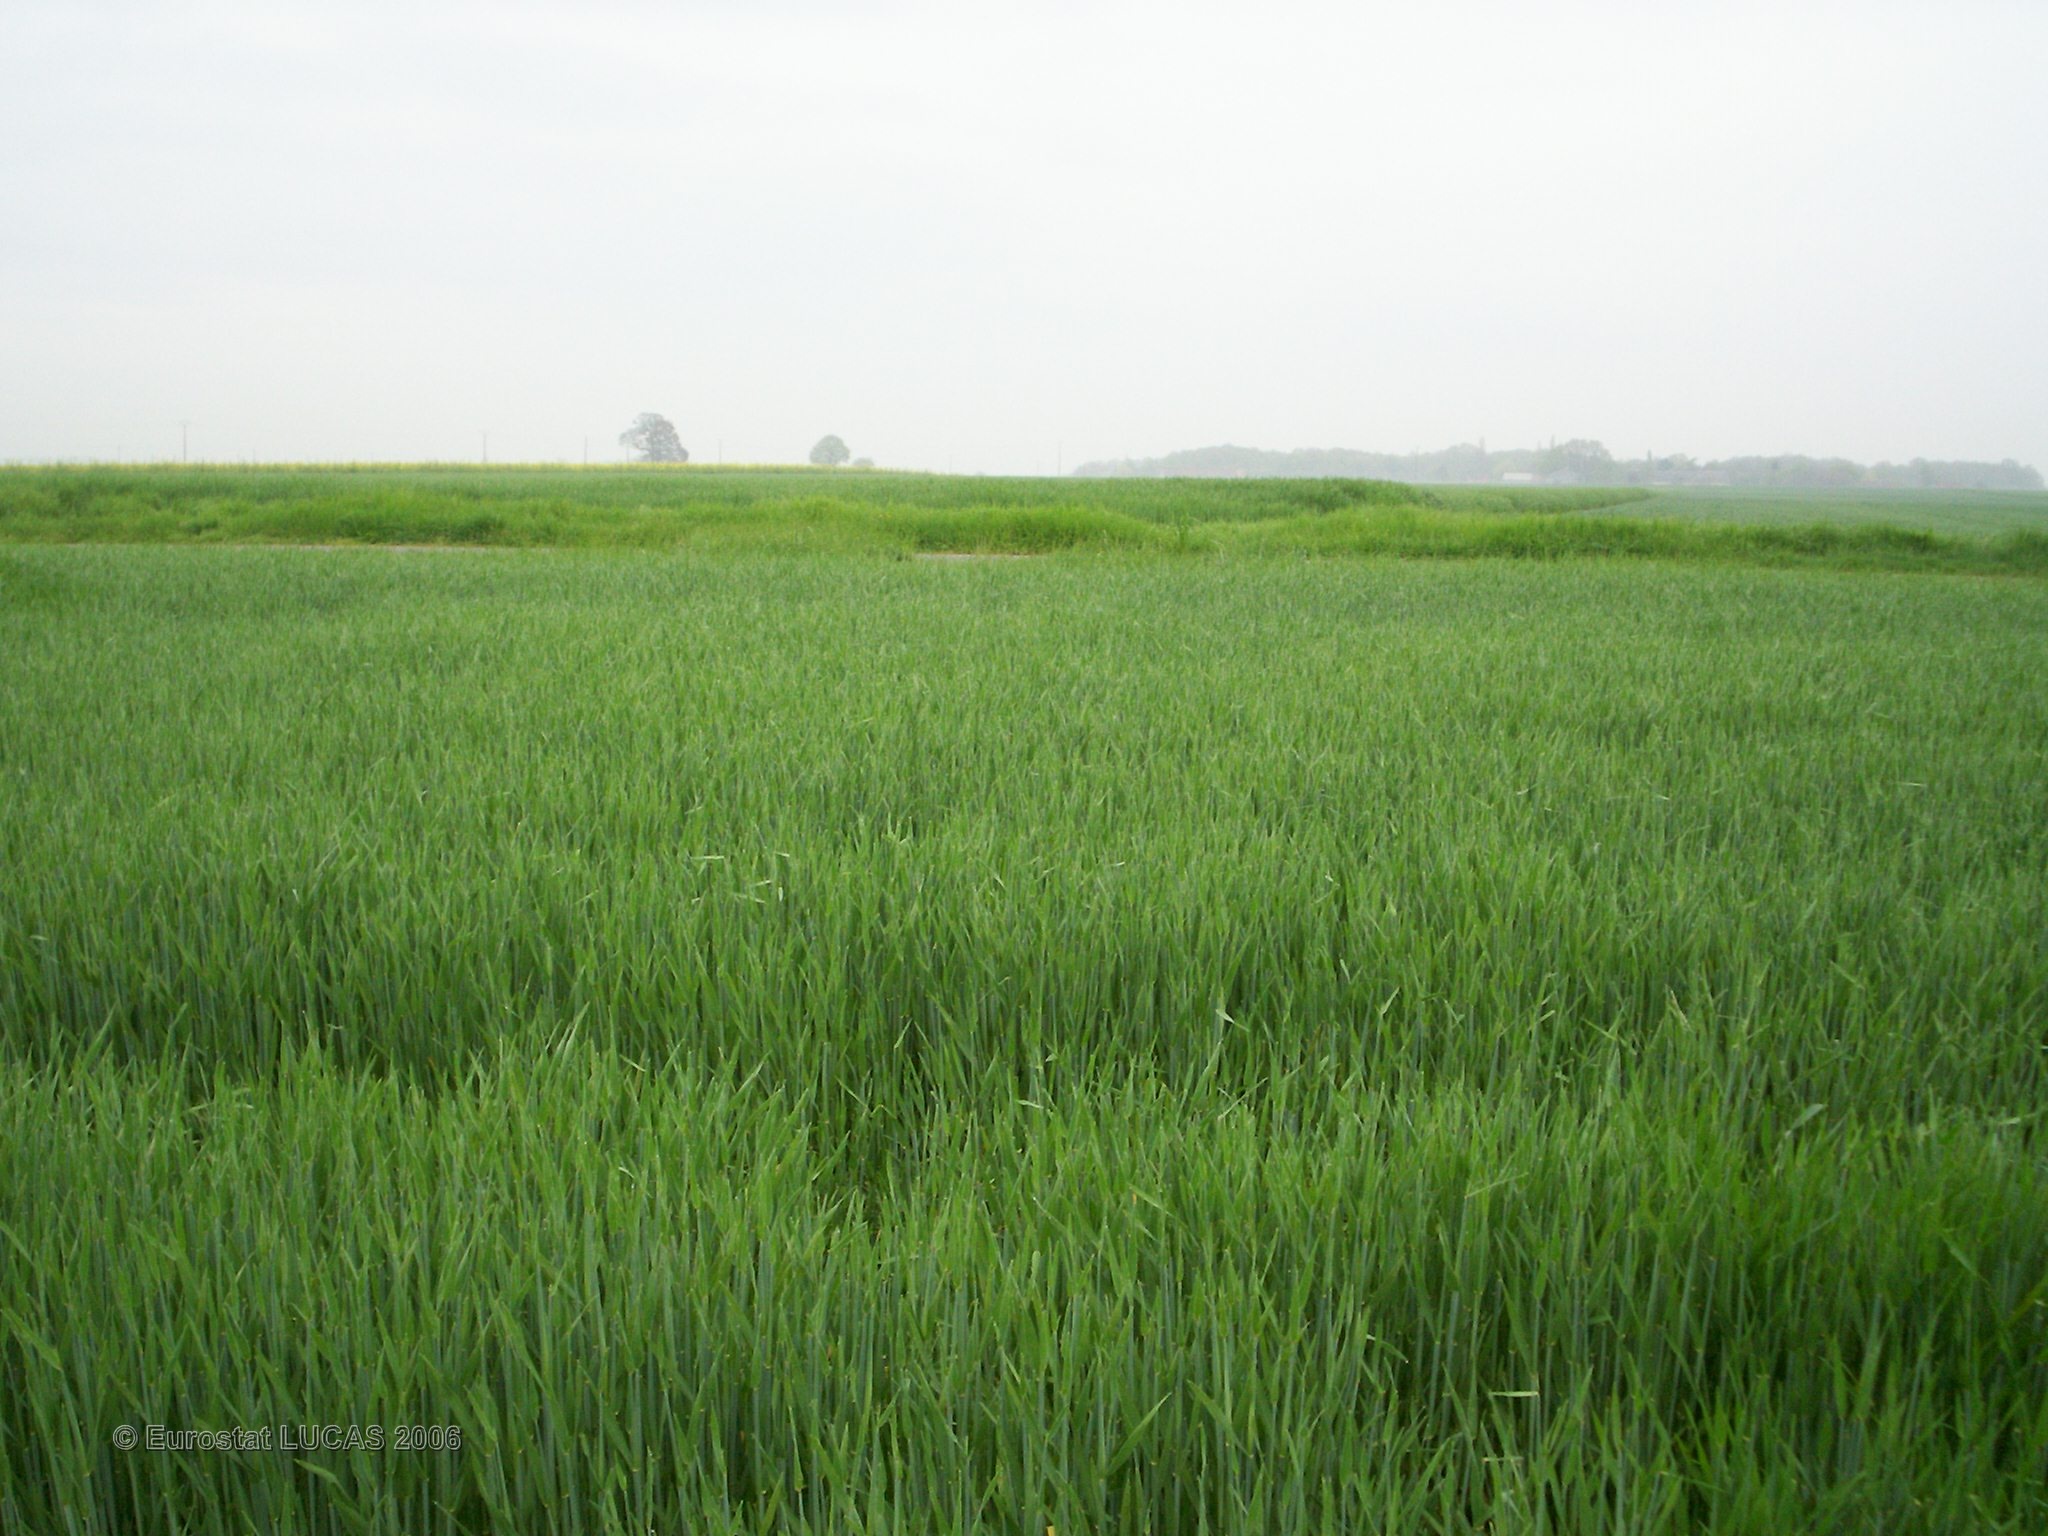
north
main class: Cropland
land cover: Barley
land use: Agriculture (excluding fallow land and kitchen gardens)
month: April
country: FR
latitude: 47.8856
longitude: 2.8916
